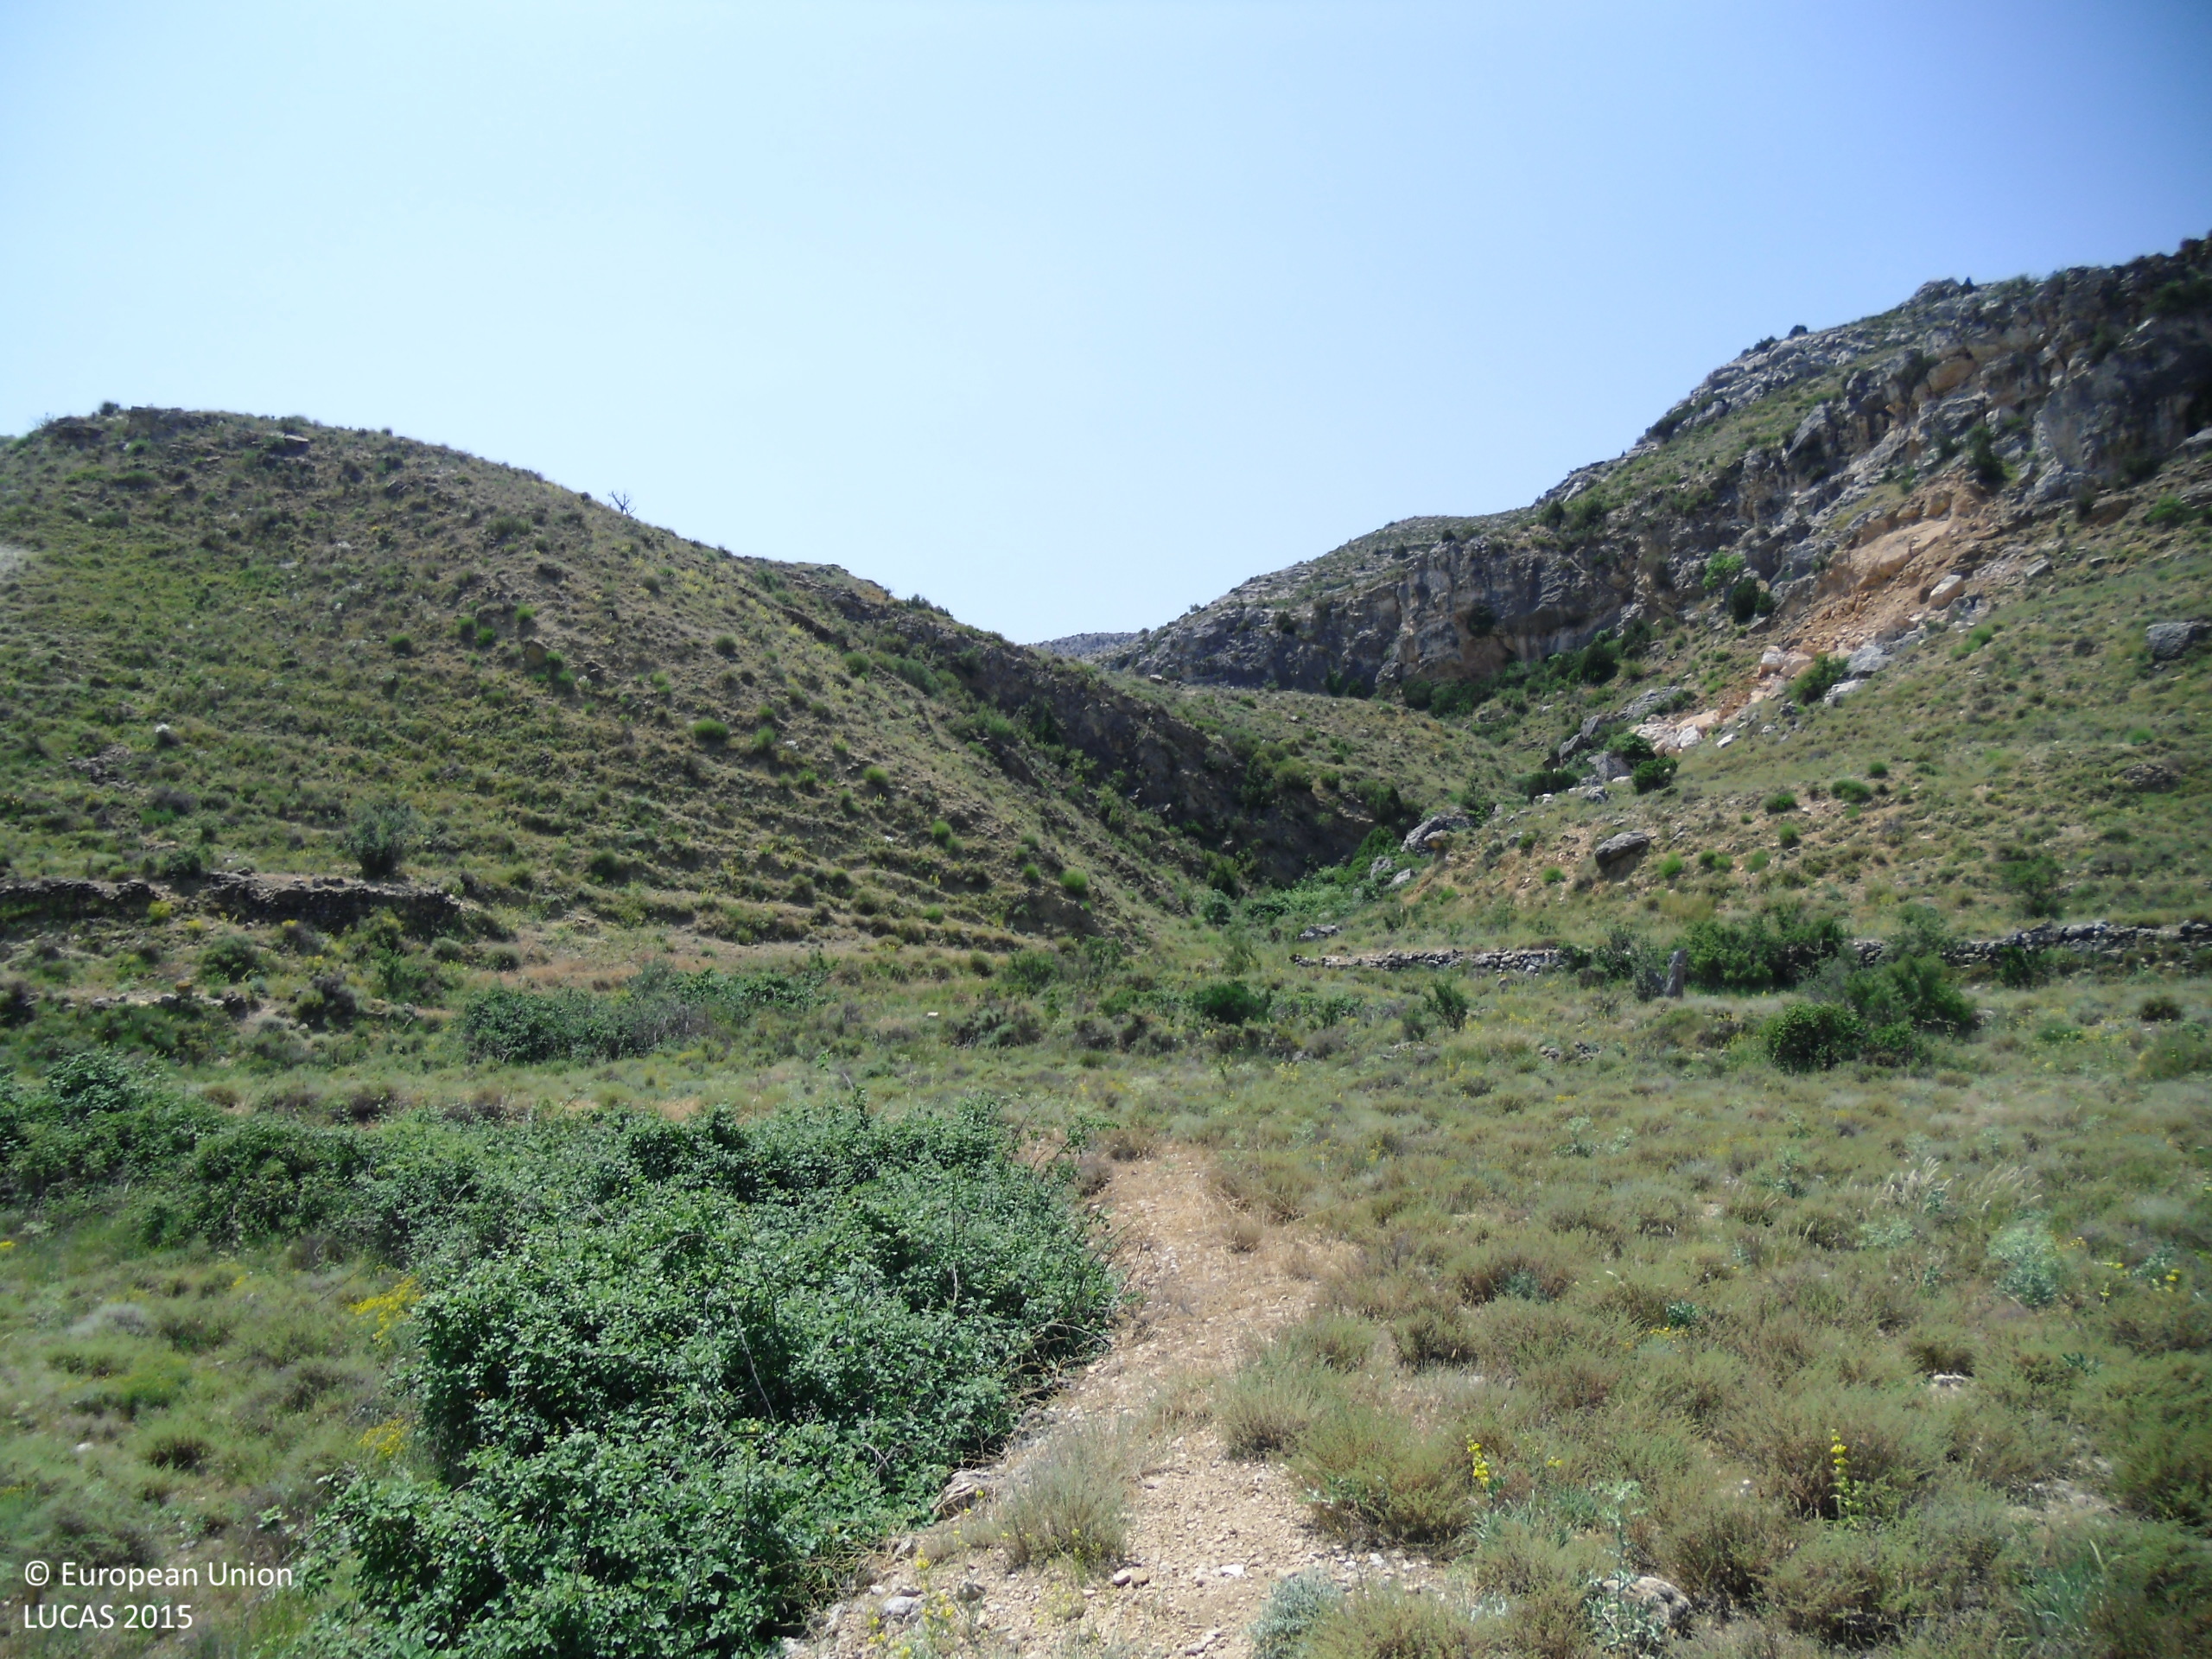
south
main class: Grassland
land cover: Grassland with sparse tree/shrub cover
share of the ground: 50 - 75 %
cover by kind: herbaceous plants 75 %, unconsolidated bare surface 15 %, coniferous forest trees 5 %, shrubs 5 %
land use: Agriculture (excluding fallow land and kitchen gardens)
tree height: < 5 m
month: June
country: ES
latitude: 40.9954
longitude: -0.6774
